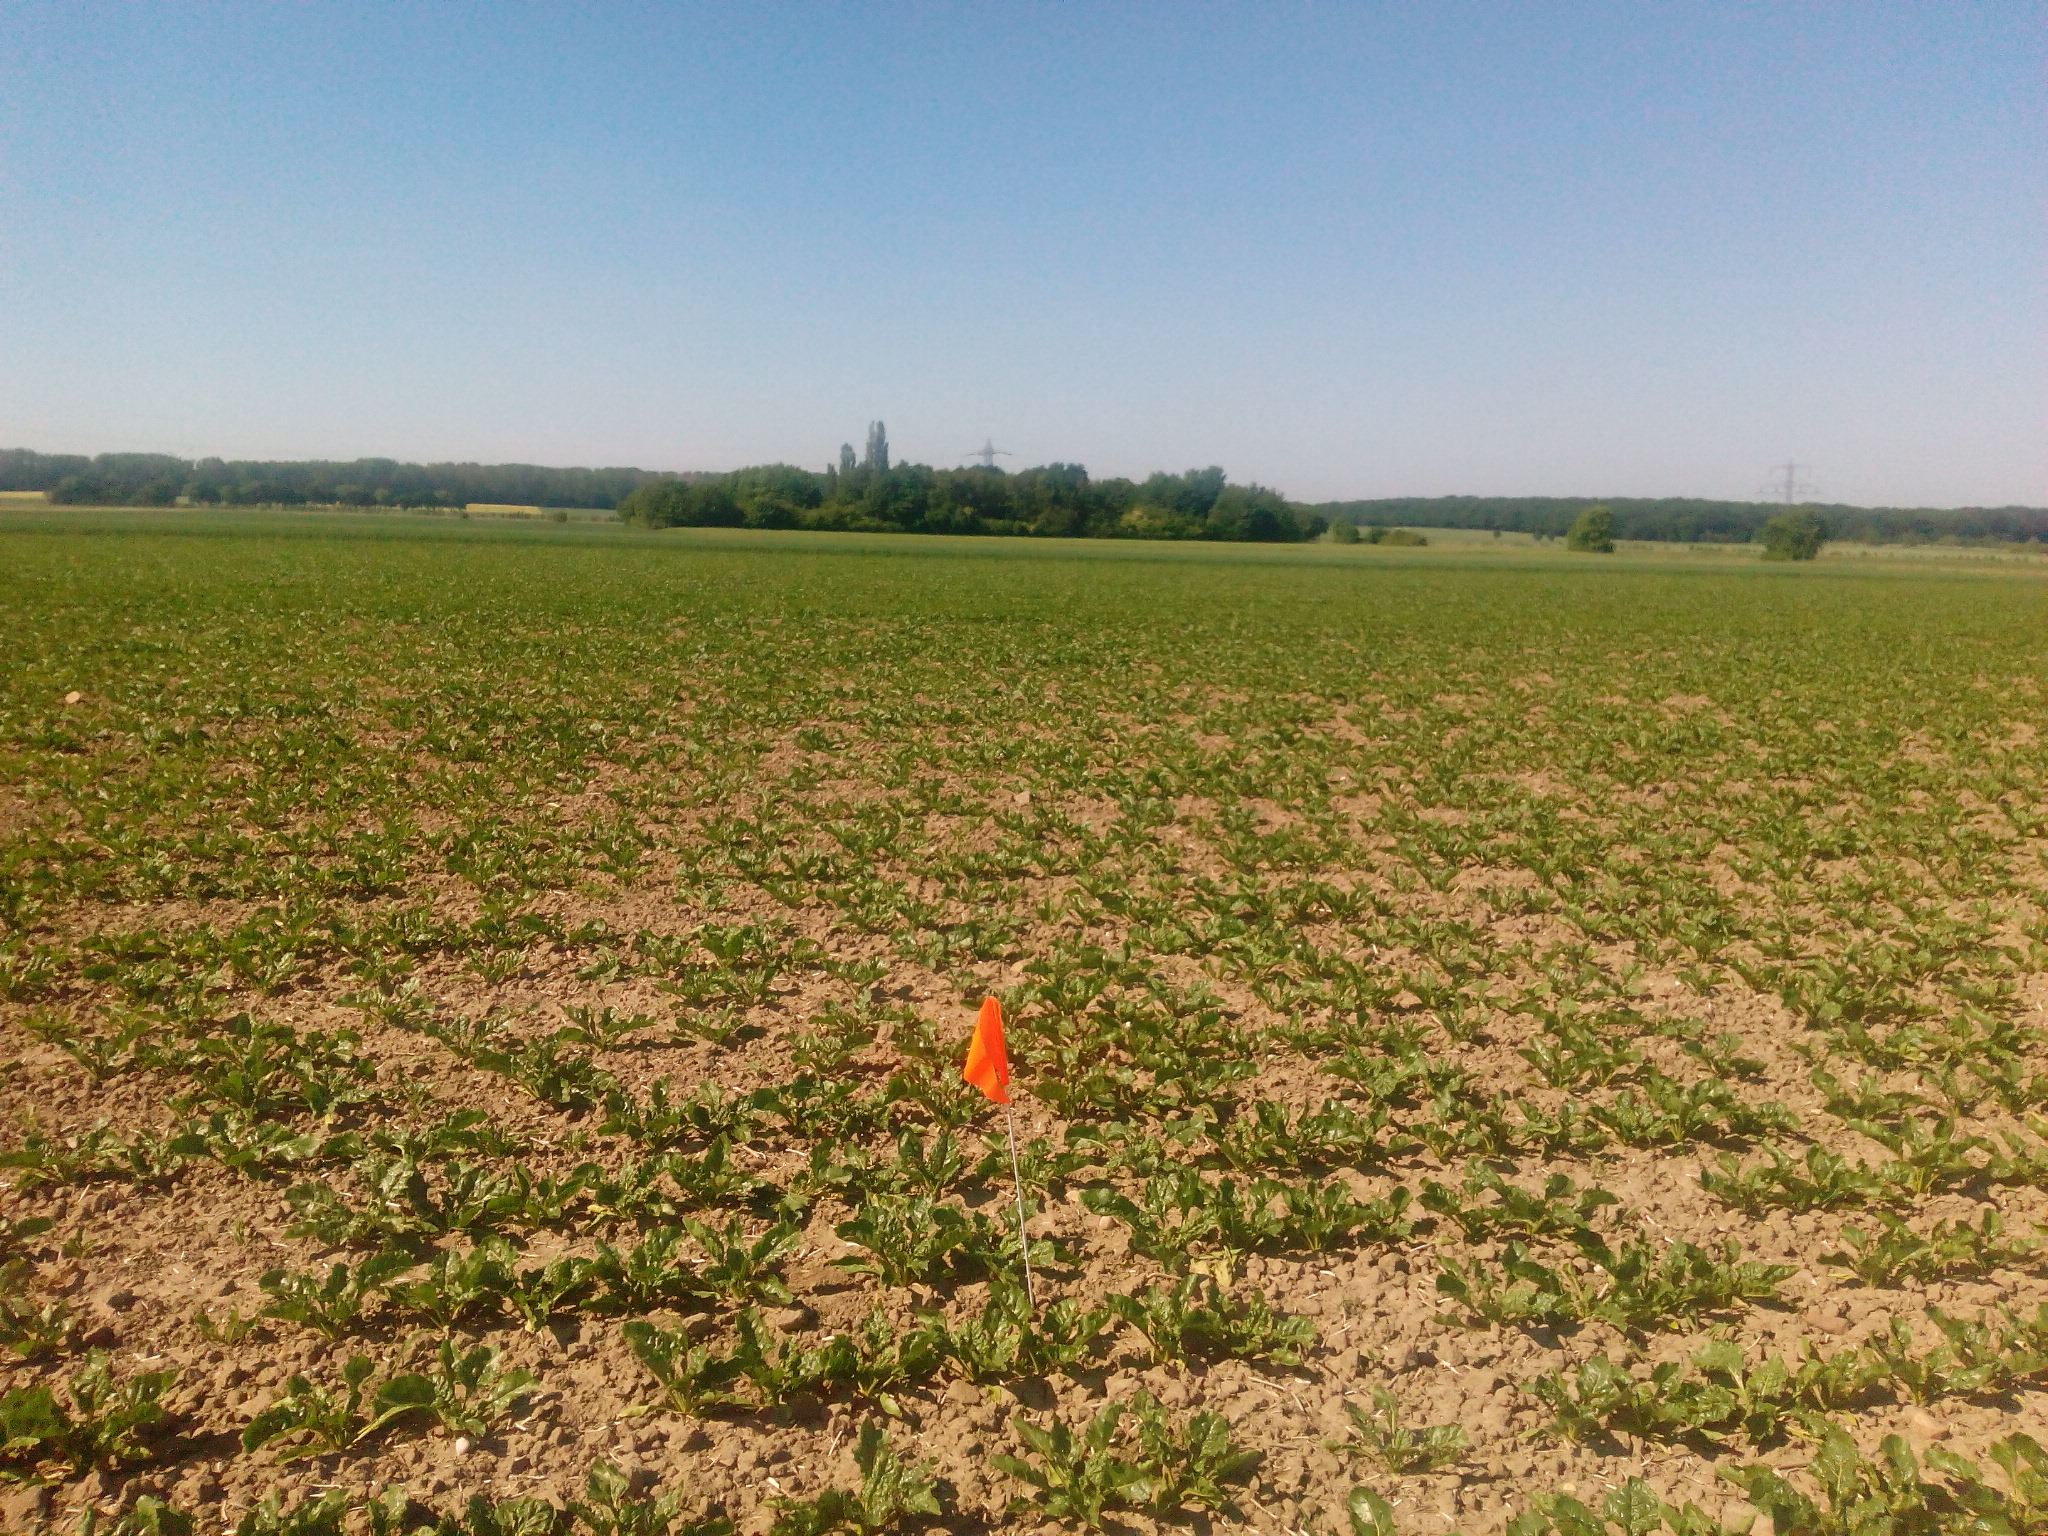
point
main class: Cropland
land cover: Sugar beet
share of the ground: 25 - 50 %
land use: Agriculture (excluding fallow land and kitchen gardens)
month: June
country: DE
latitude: 52.2875
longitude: 9.8681
